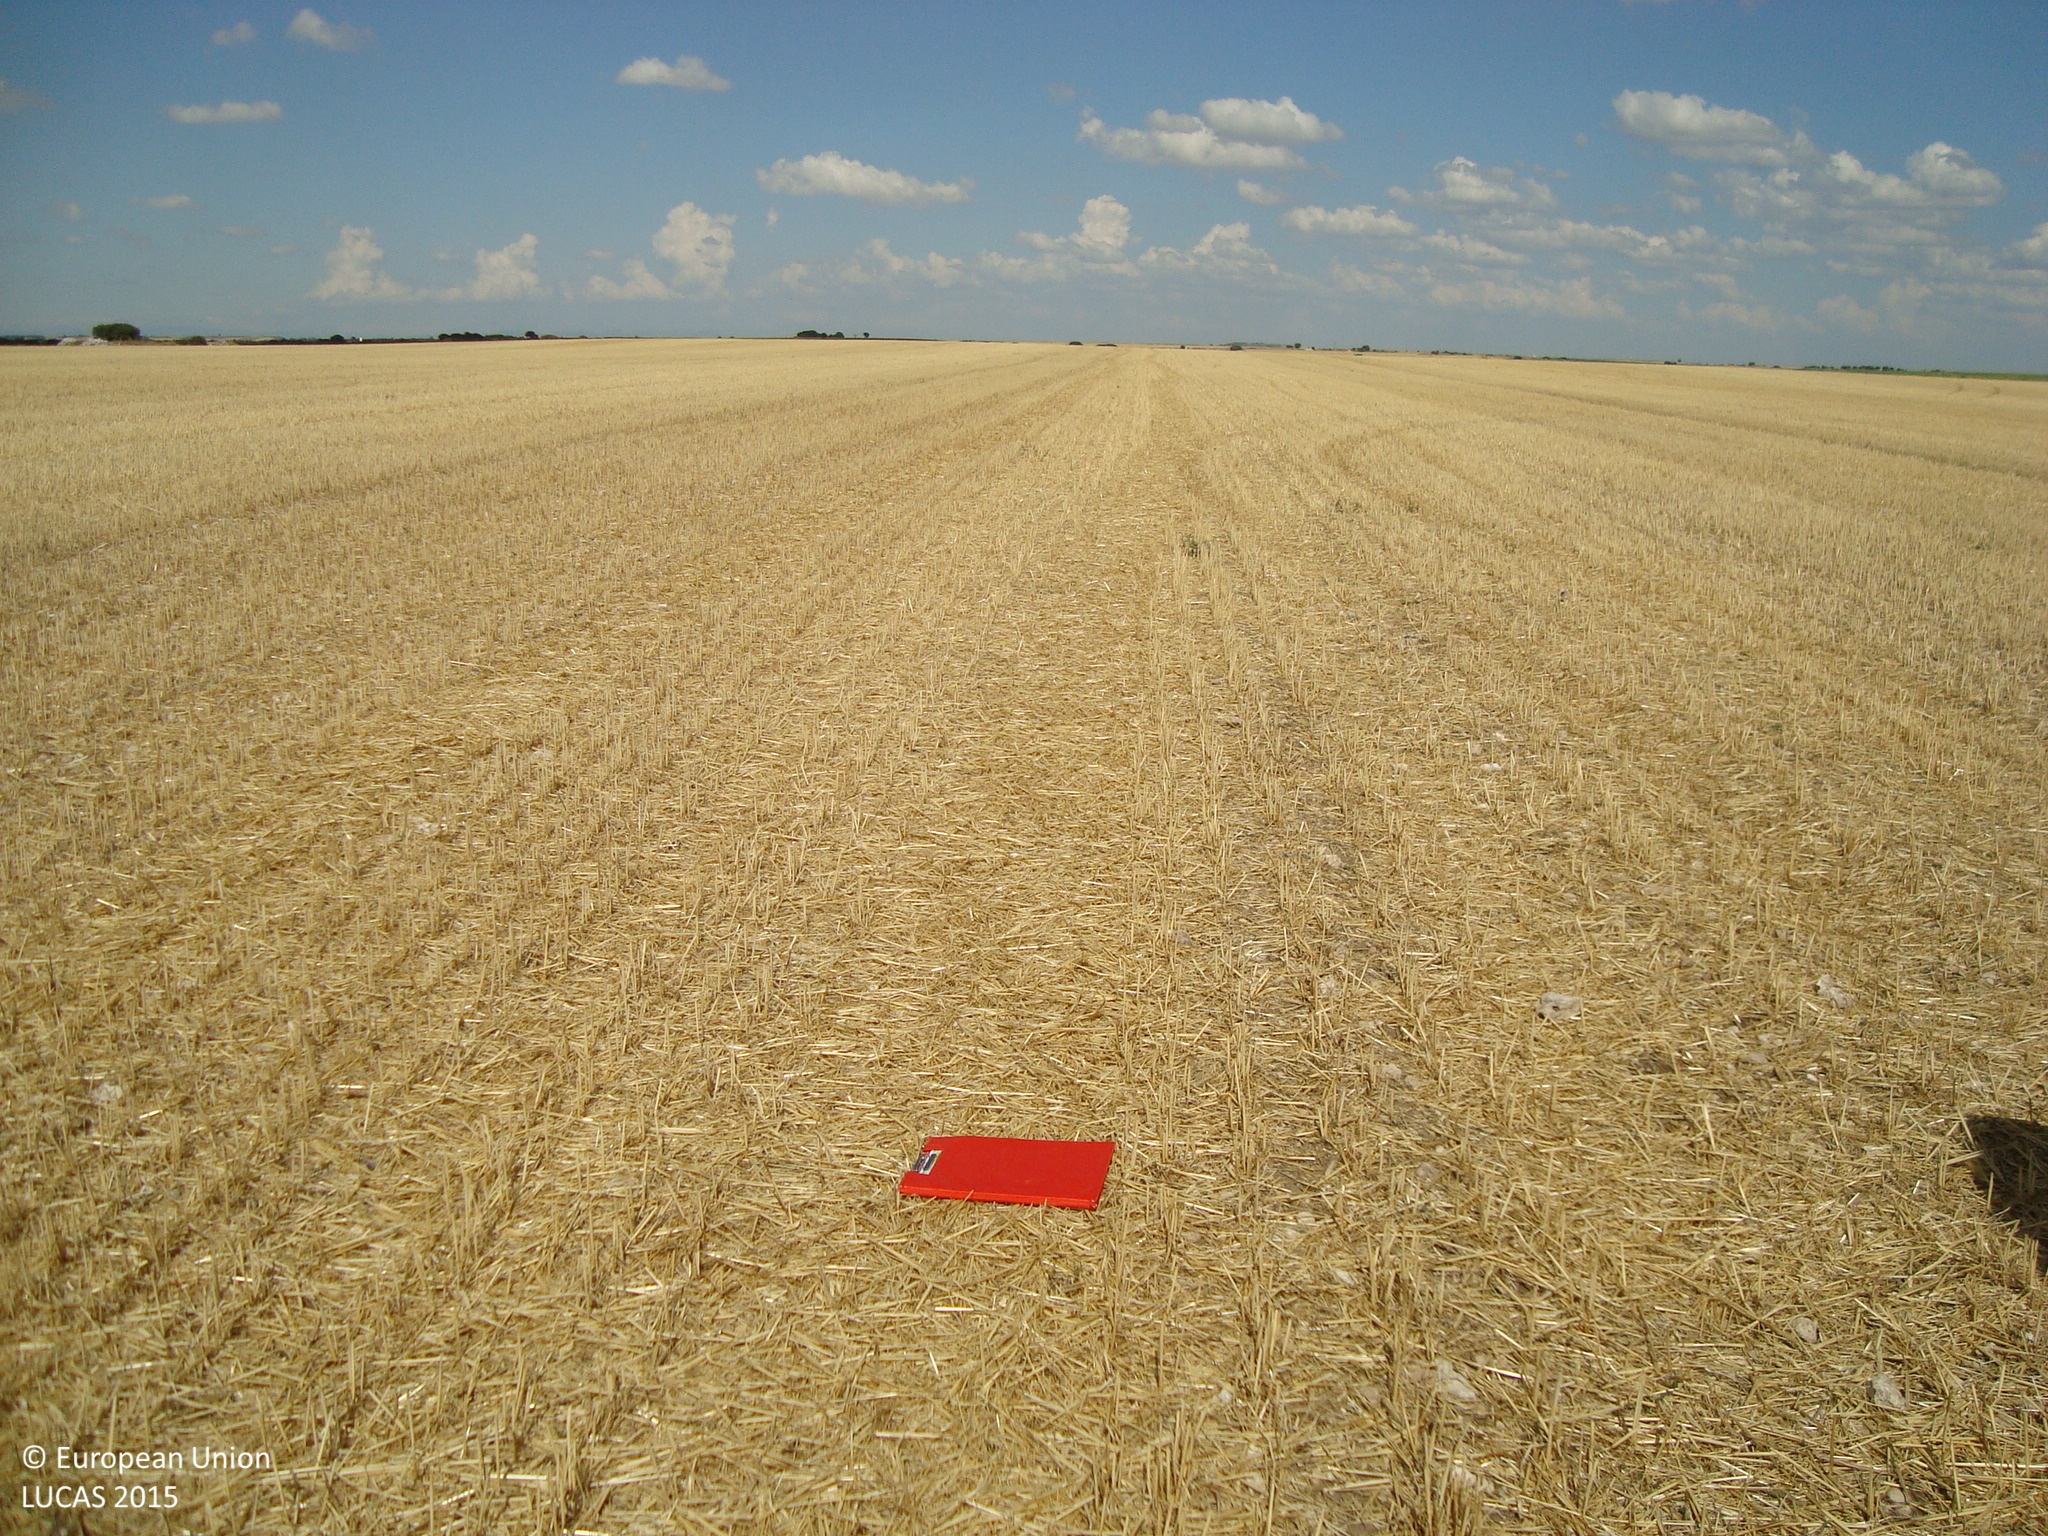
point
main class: Cropland
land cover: Barley
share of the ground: > 75 %
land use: Agriculture (excluding fallow land and kitchen gardens)
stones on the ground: < 10 %
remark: Harvested field
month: July
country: ES
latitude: 41.7189
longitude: -4.0867
